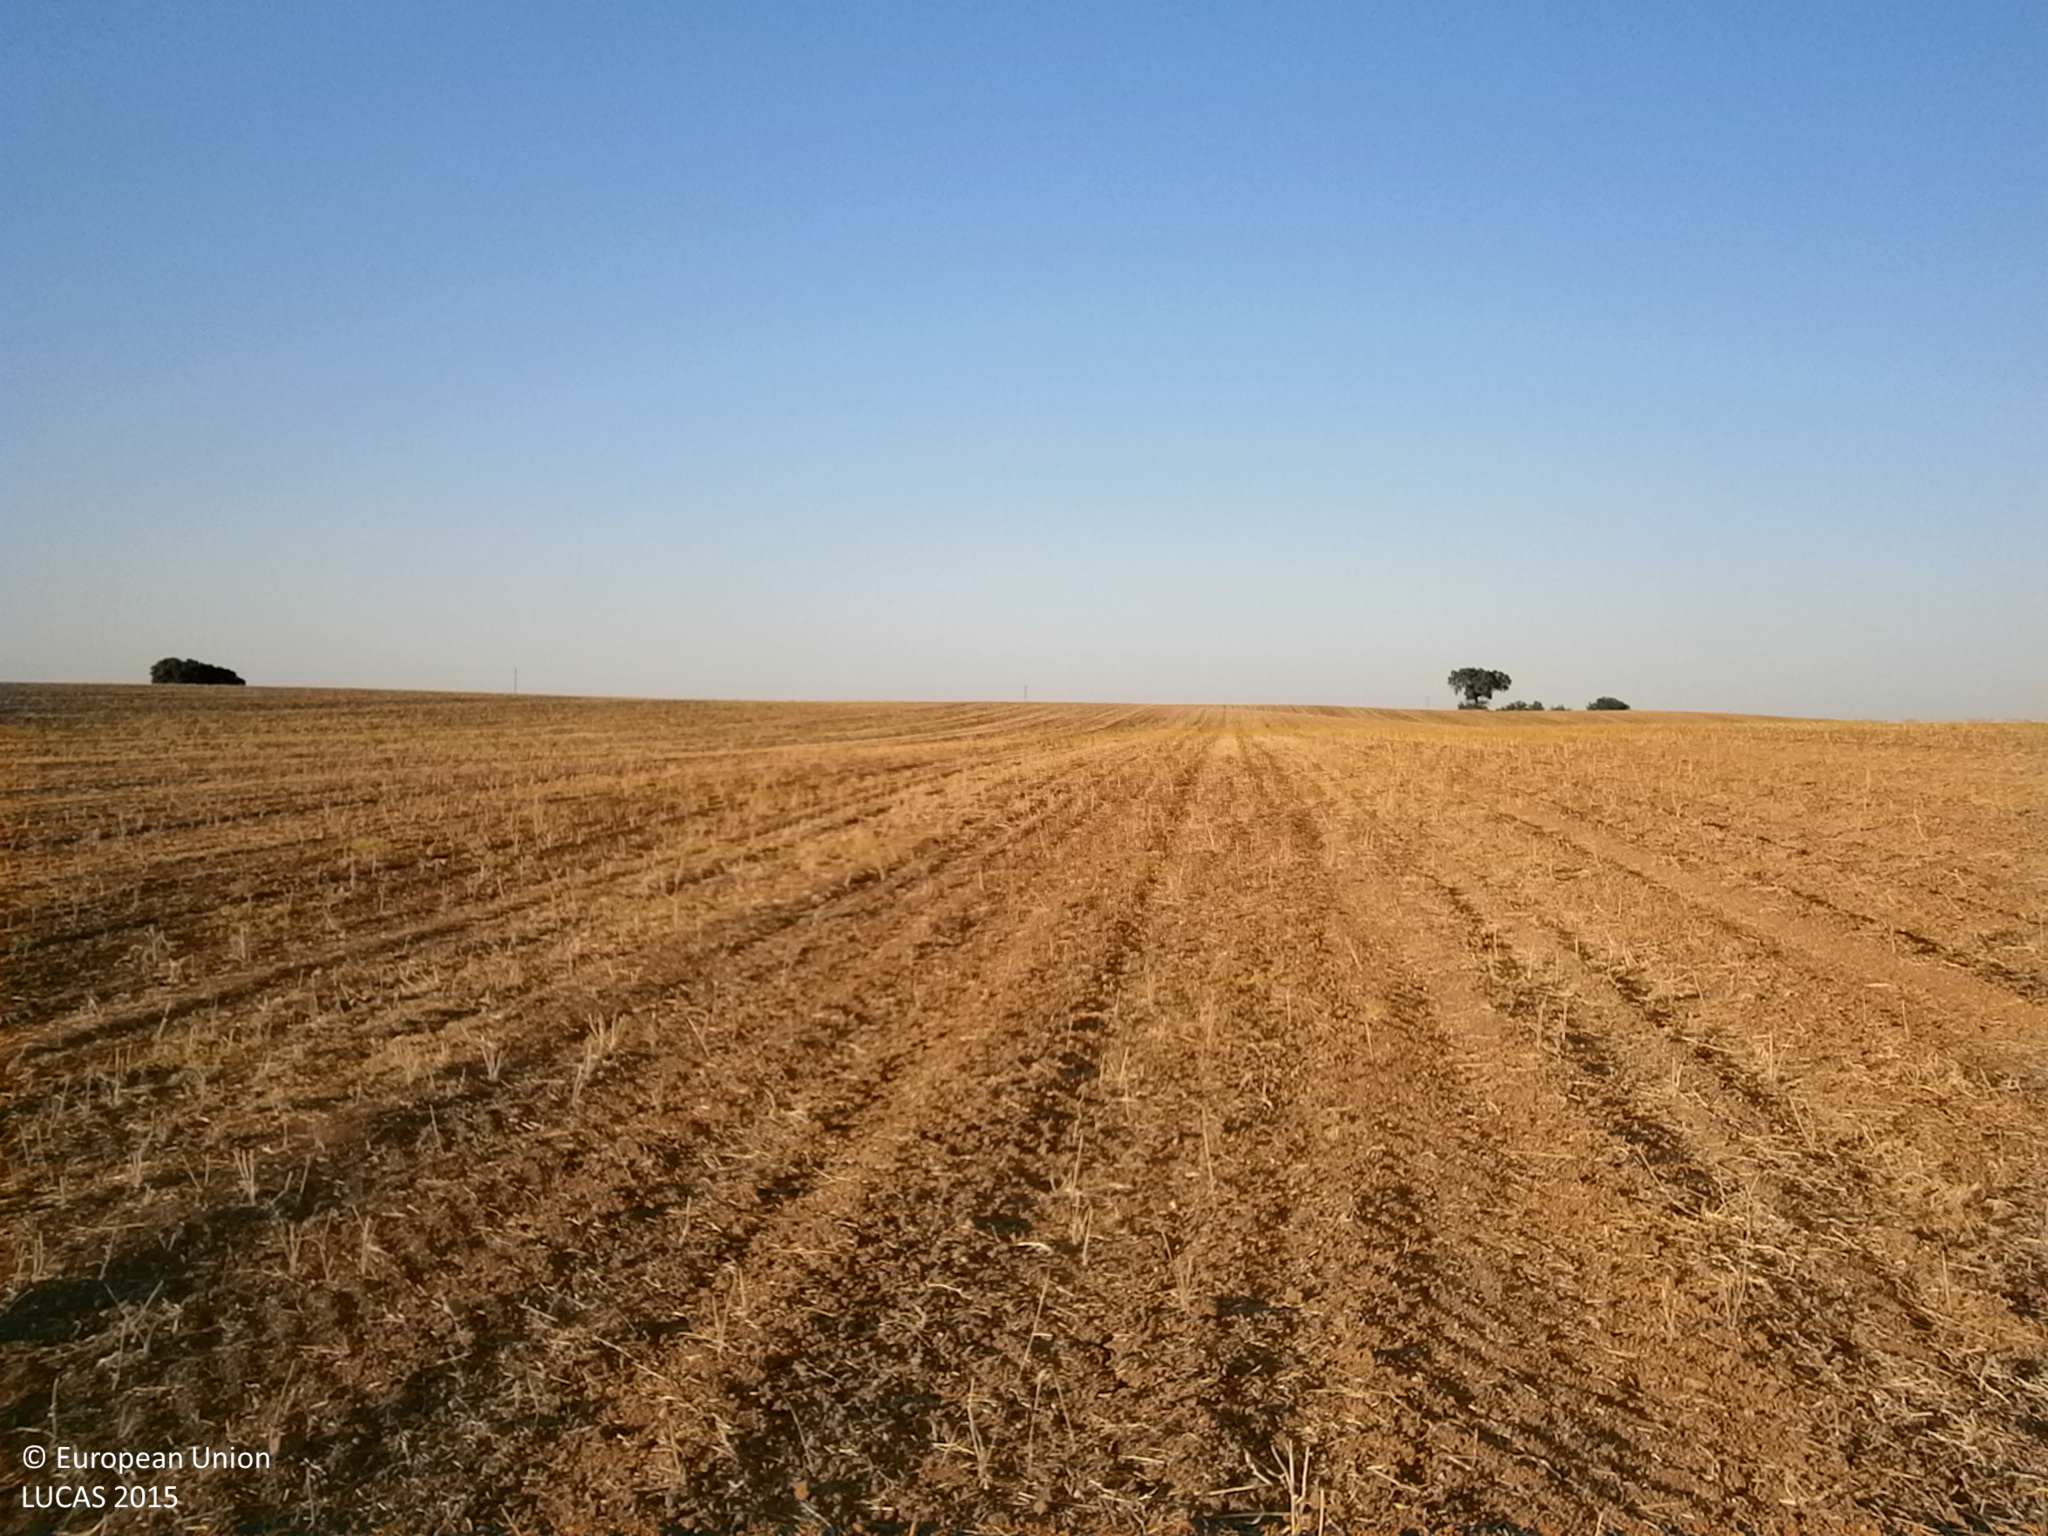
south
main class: Grassland
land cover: Spontaneously vegetated surfaces
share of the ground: 25 - 50 %
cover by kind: unconsolidated bare surface 65 %, herbaceous plants 30 %
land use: Agriculture (excluding fallow land and kitchen gardens)
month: June
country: ES
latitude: 38.7739
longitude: -6.8824
